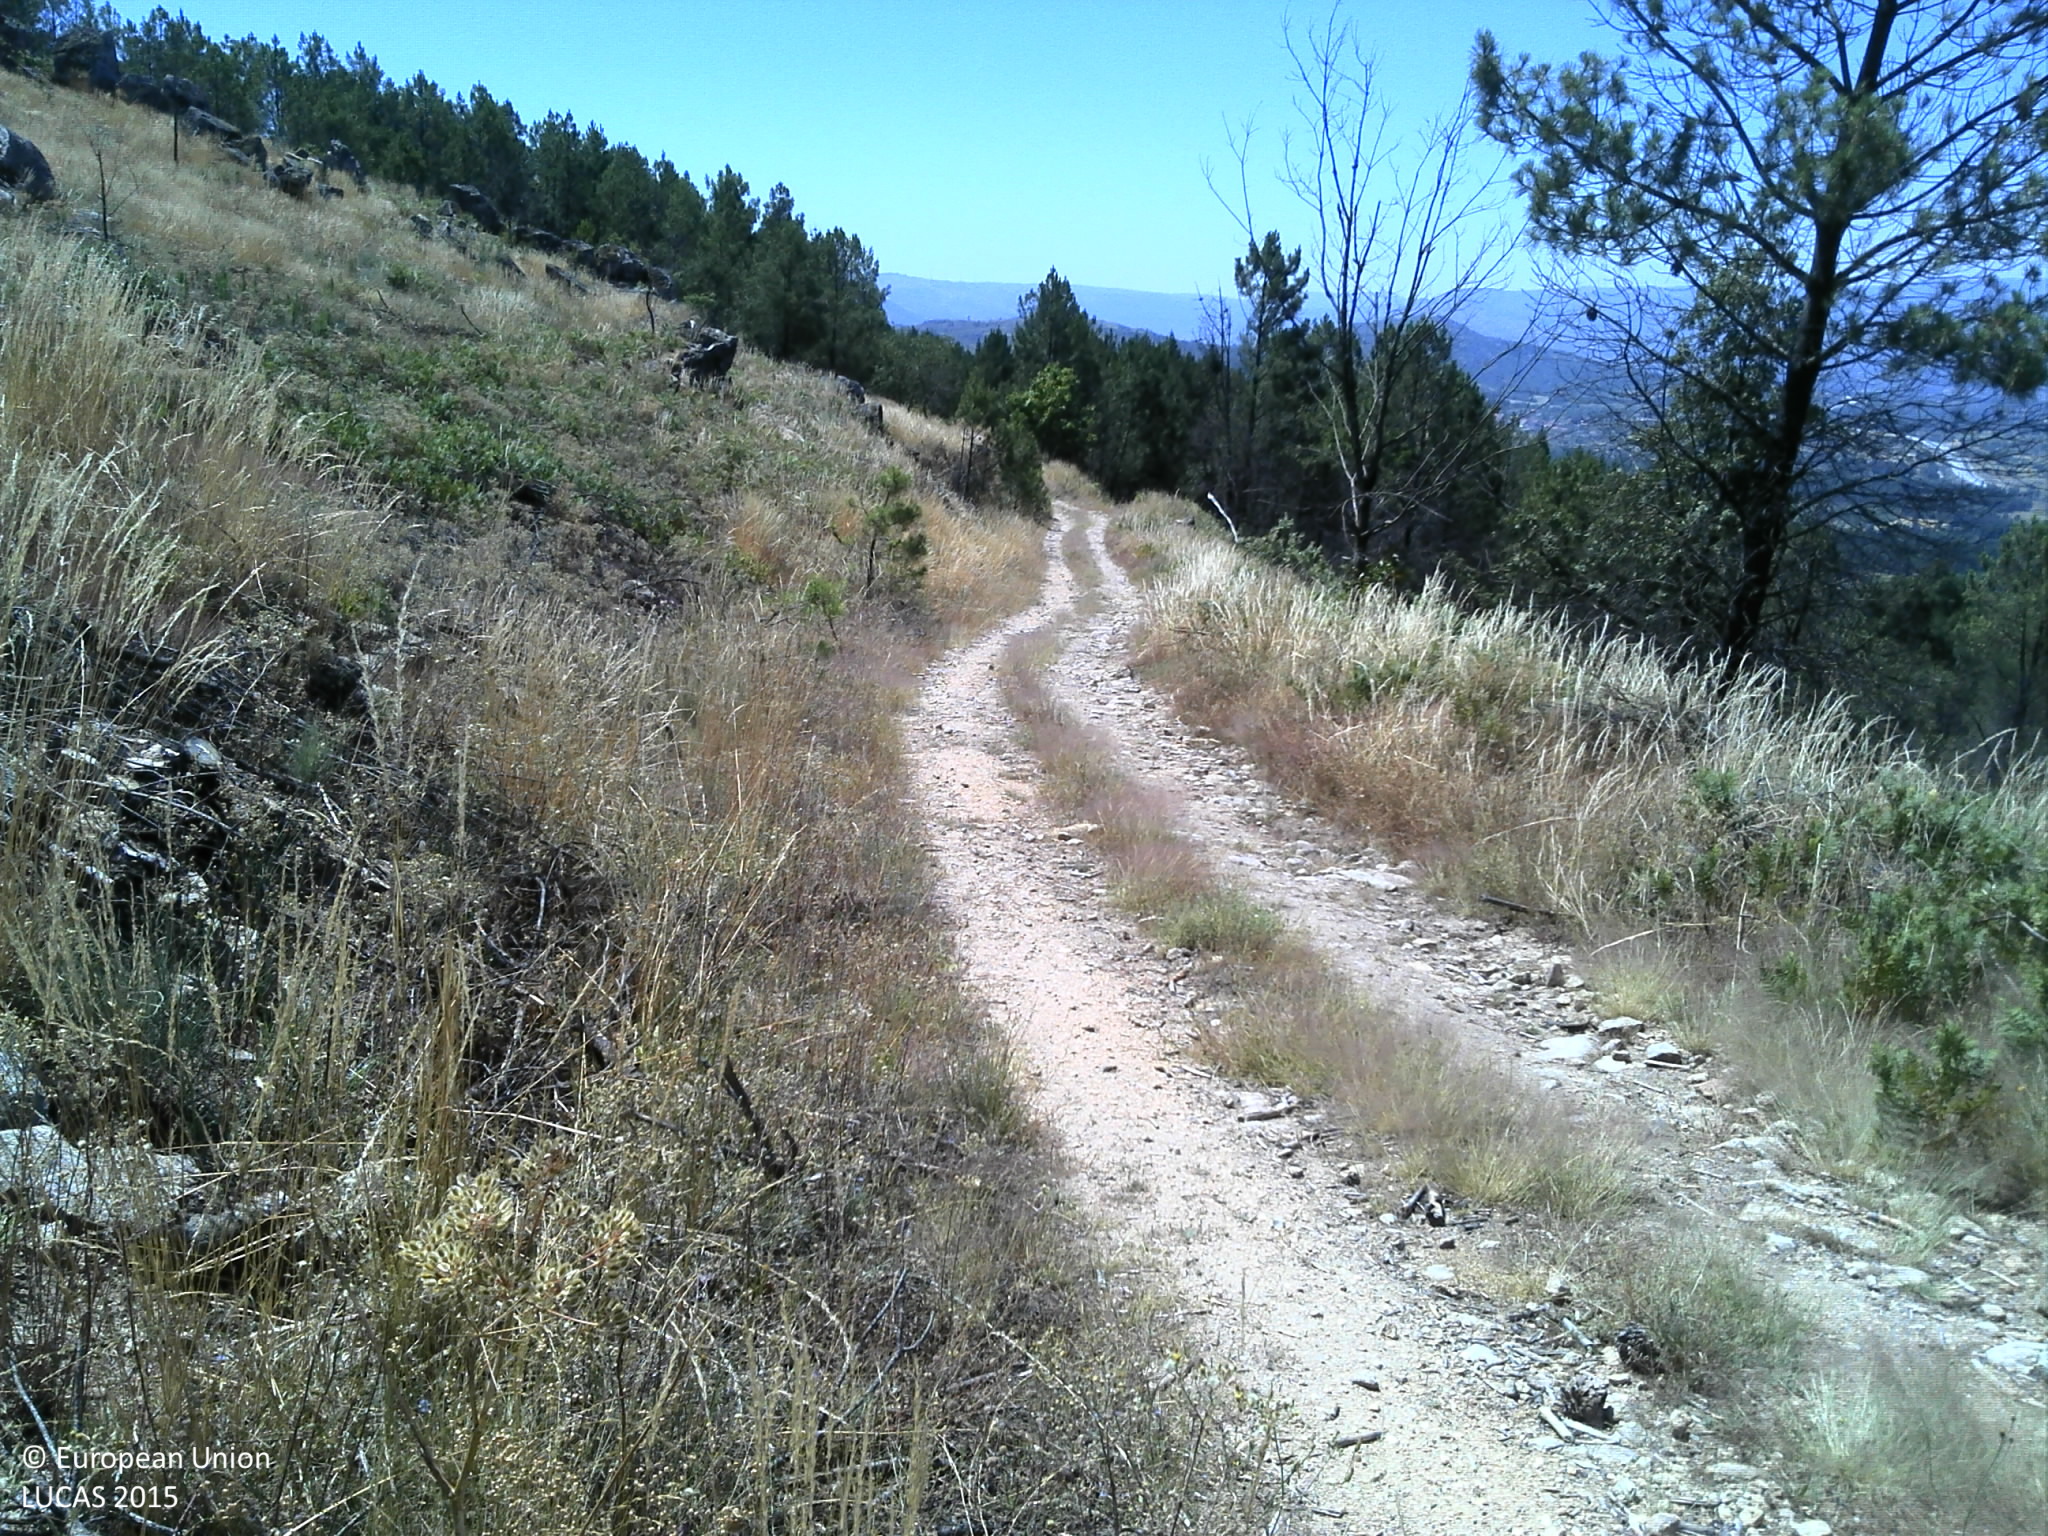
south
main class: Grassland
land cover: Spontaneously vegetated surfaces
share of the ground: > 75 %
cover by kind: herbaceous plants 95 %, unconsolidated bare surface 5 %
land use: Abandoned areas
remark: Burnt area
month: June
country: PT
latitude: 40.7298
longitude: -7.2898
